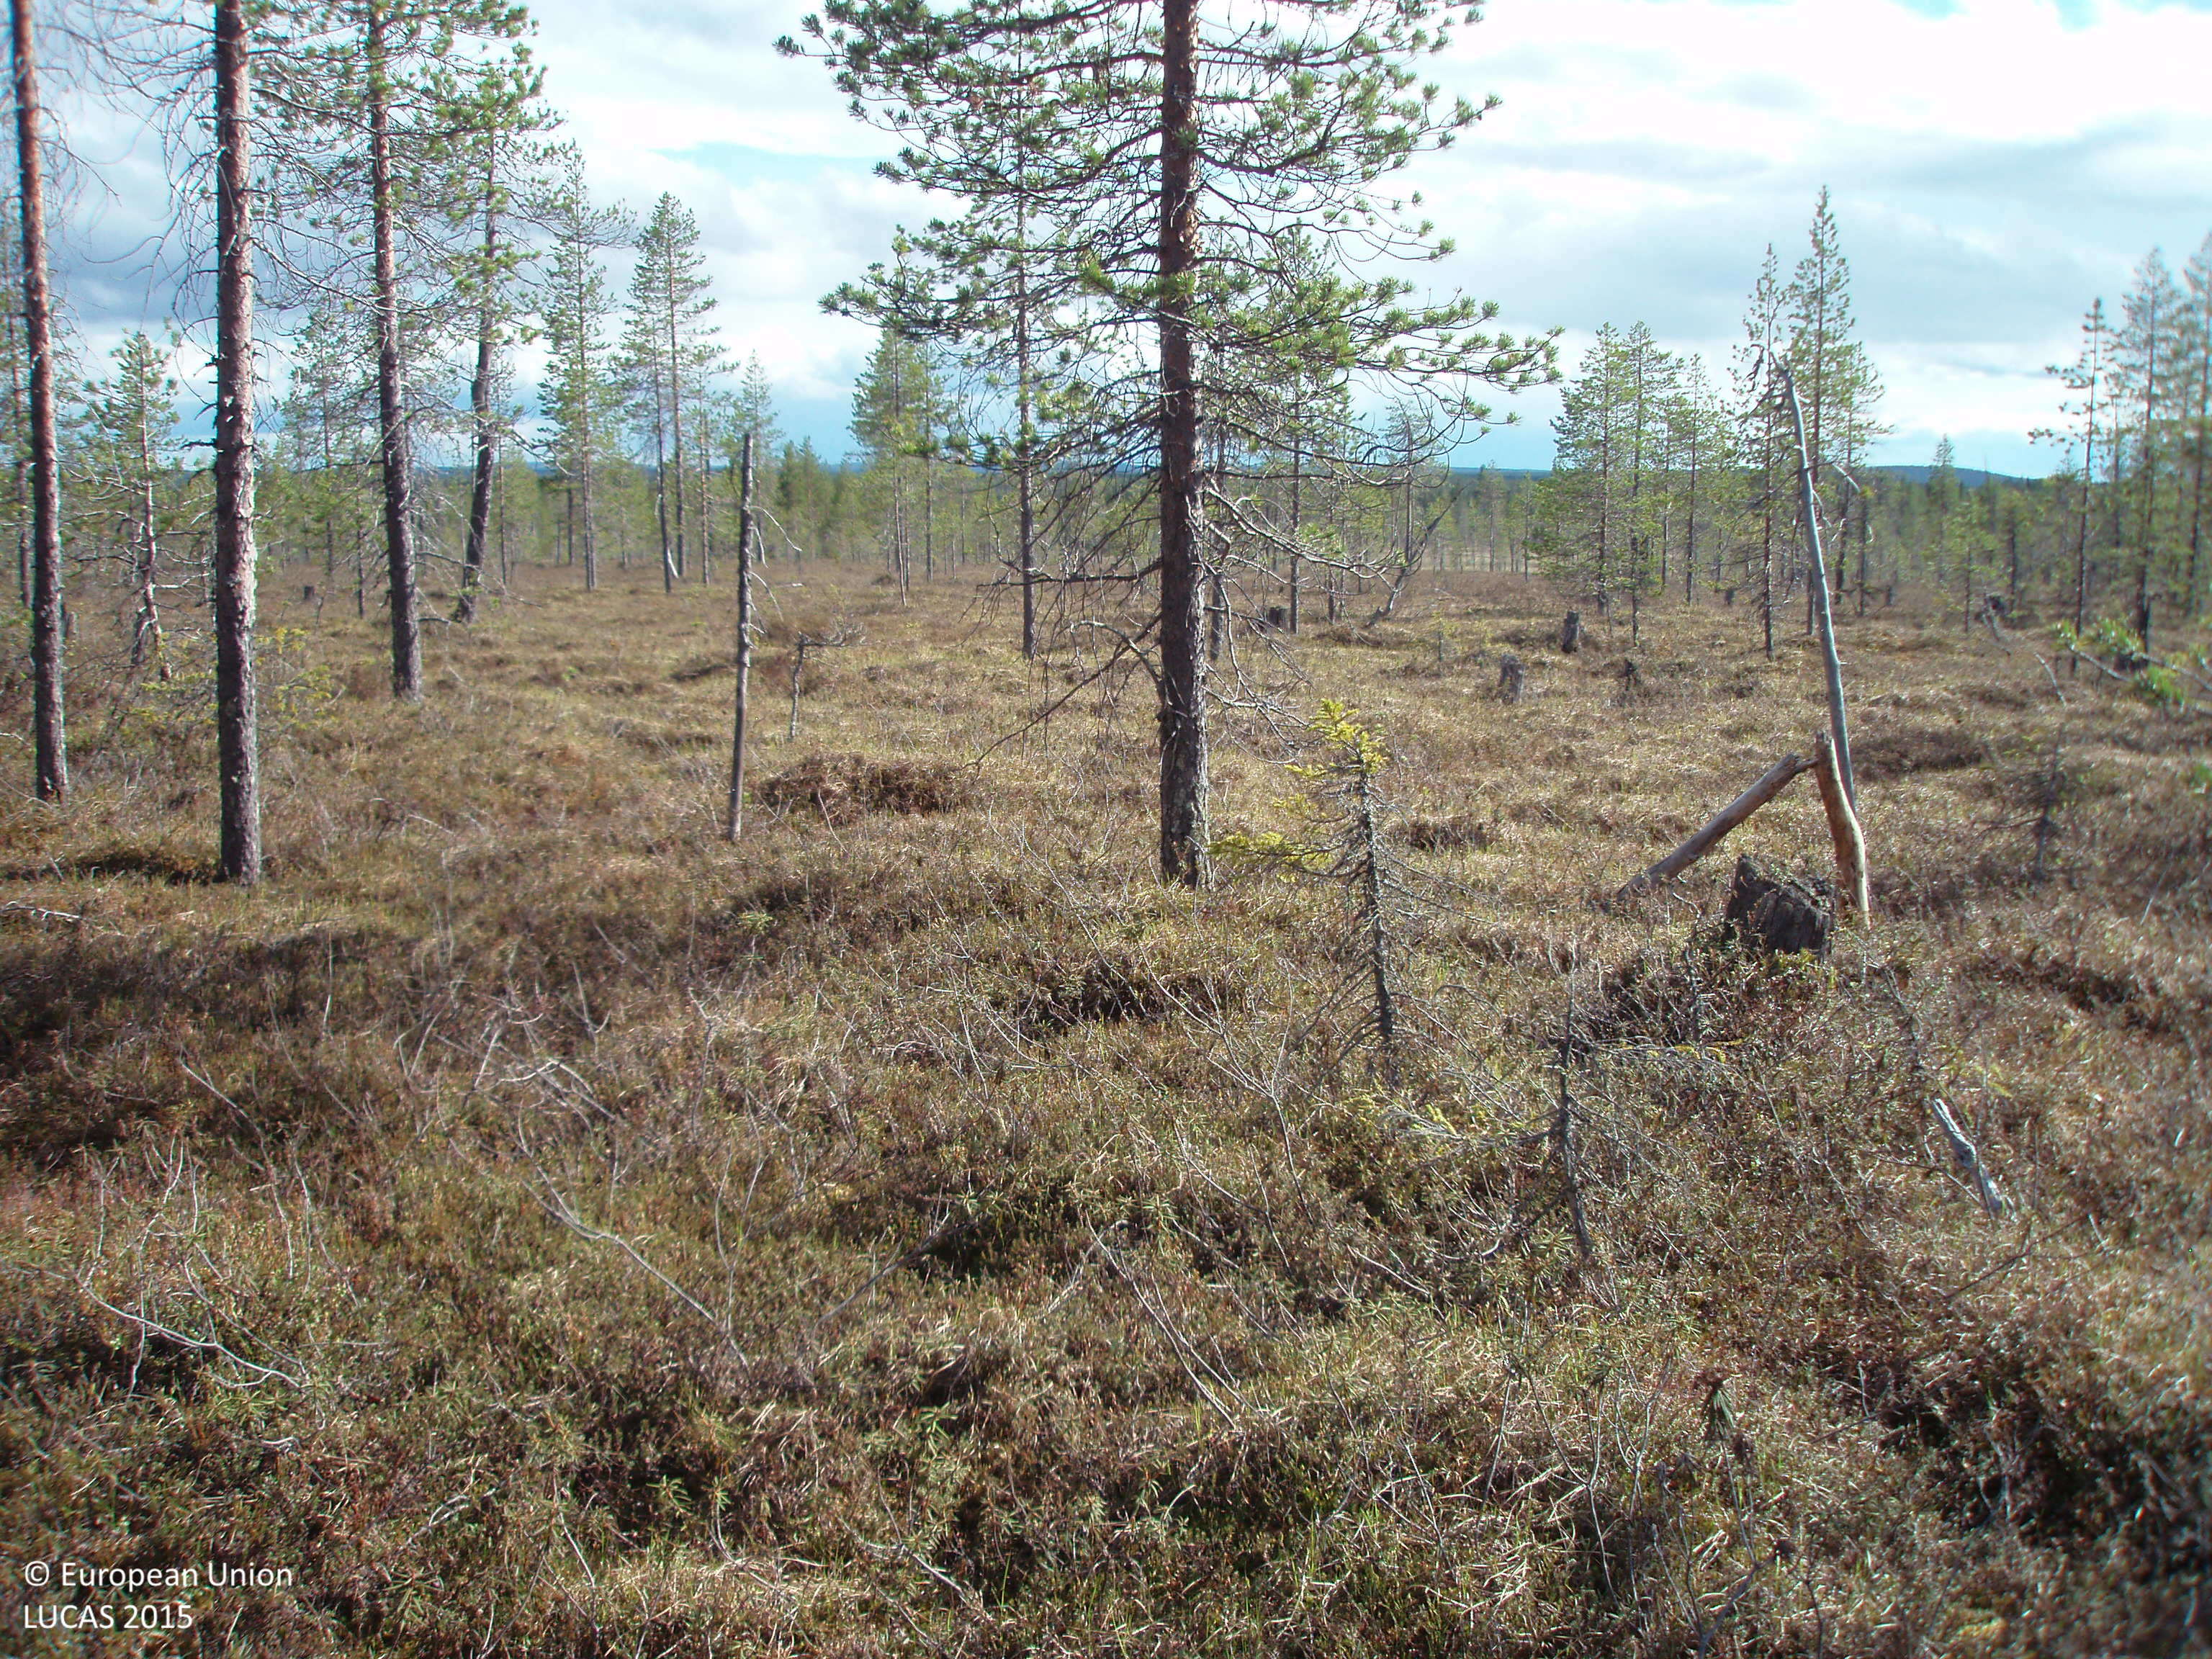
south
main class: Woodland
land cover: Pine dominated coniferous woodland
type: mire and swamp forests
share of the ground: 50 - 75 %
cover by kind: coniferous forest trees 50 %, shrubs 25 %, herbaceous plants 20 %, broadleaved forest trees 5 %
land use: Forestry
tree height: > 5 m
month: June
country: FI
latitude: 66.7227
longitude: 26.8507
